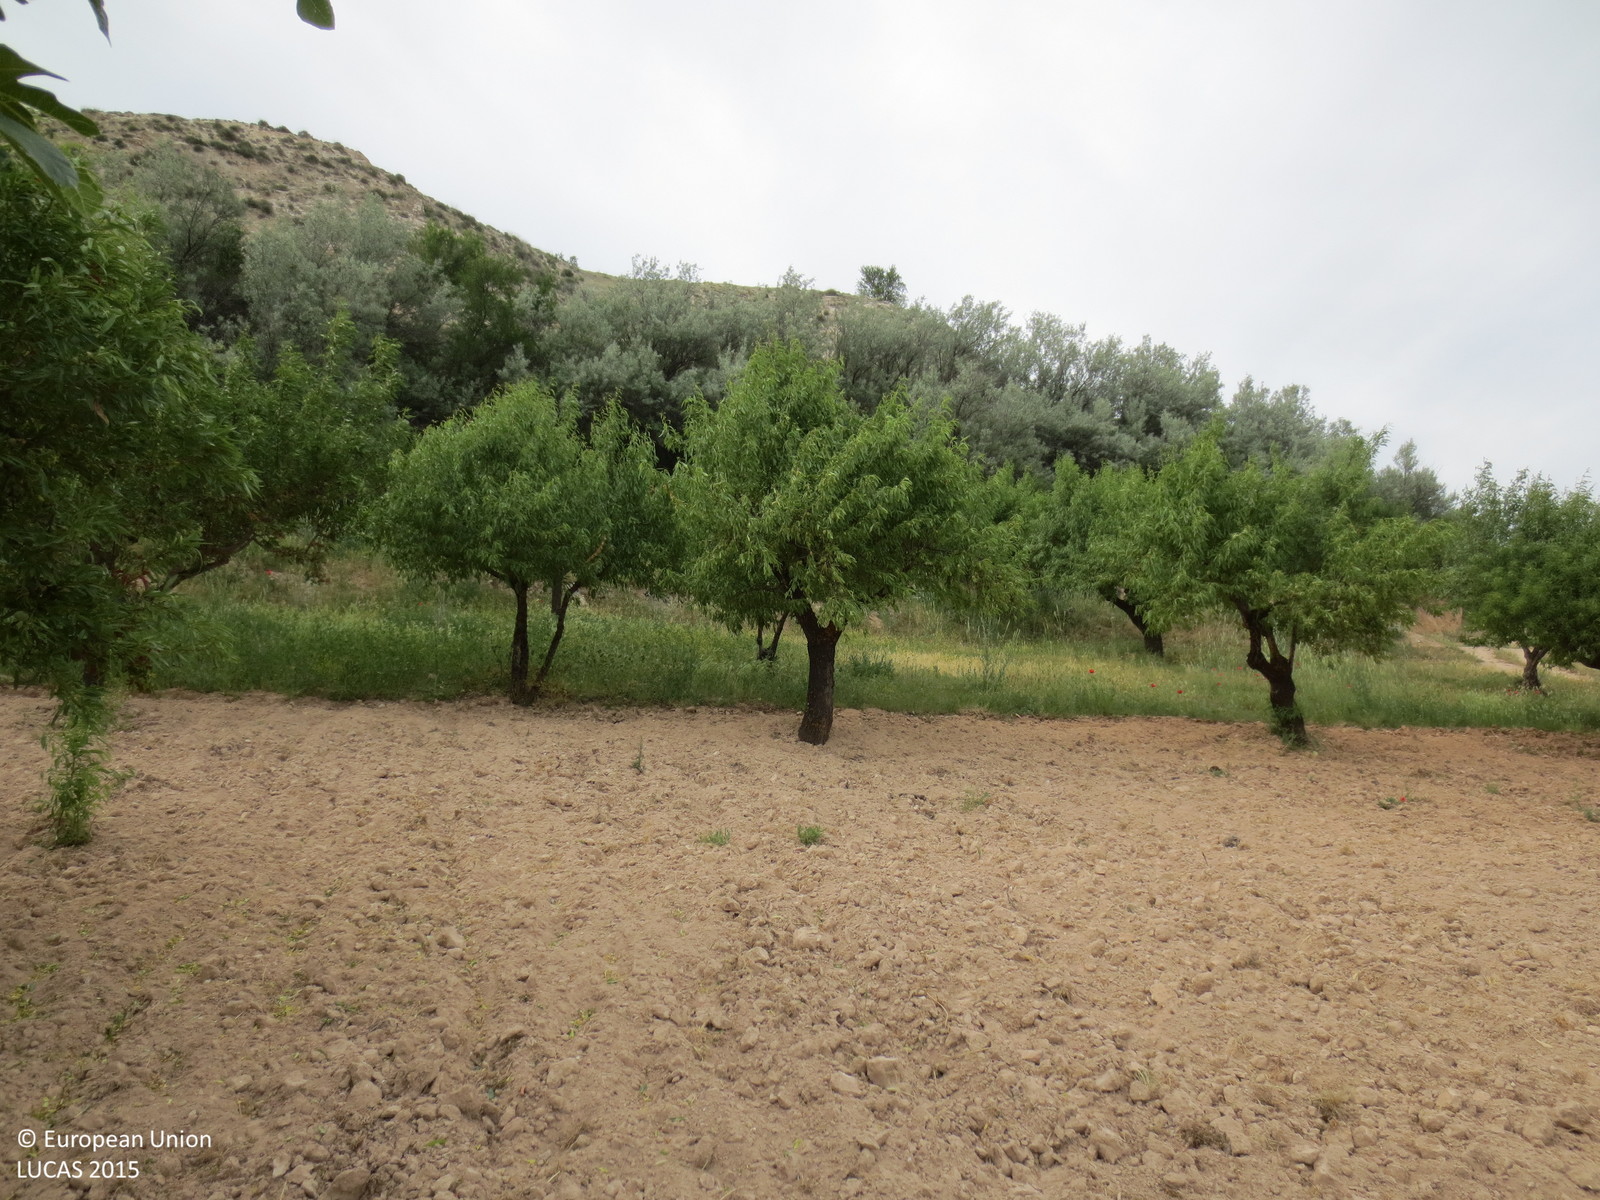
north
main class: Cropland
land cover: Nuts trees
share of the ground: 25 - 50 %
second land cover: Other fruit trees and berries
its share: 25 - 50 %
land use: Agriculture (excluding fallow land and kitchen gardens)
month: May
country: ES
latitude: 40.3761
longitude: -2.5197
